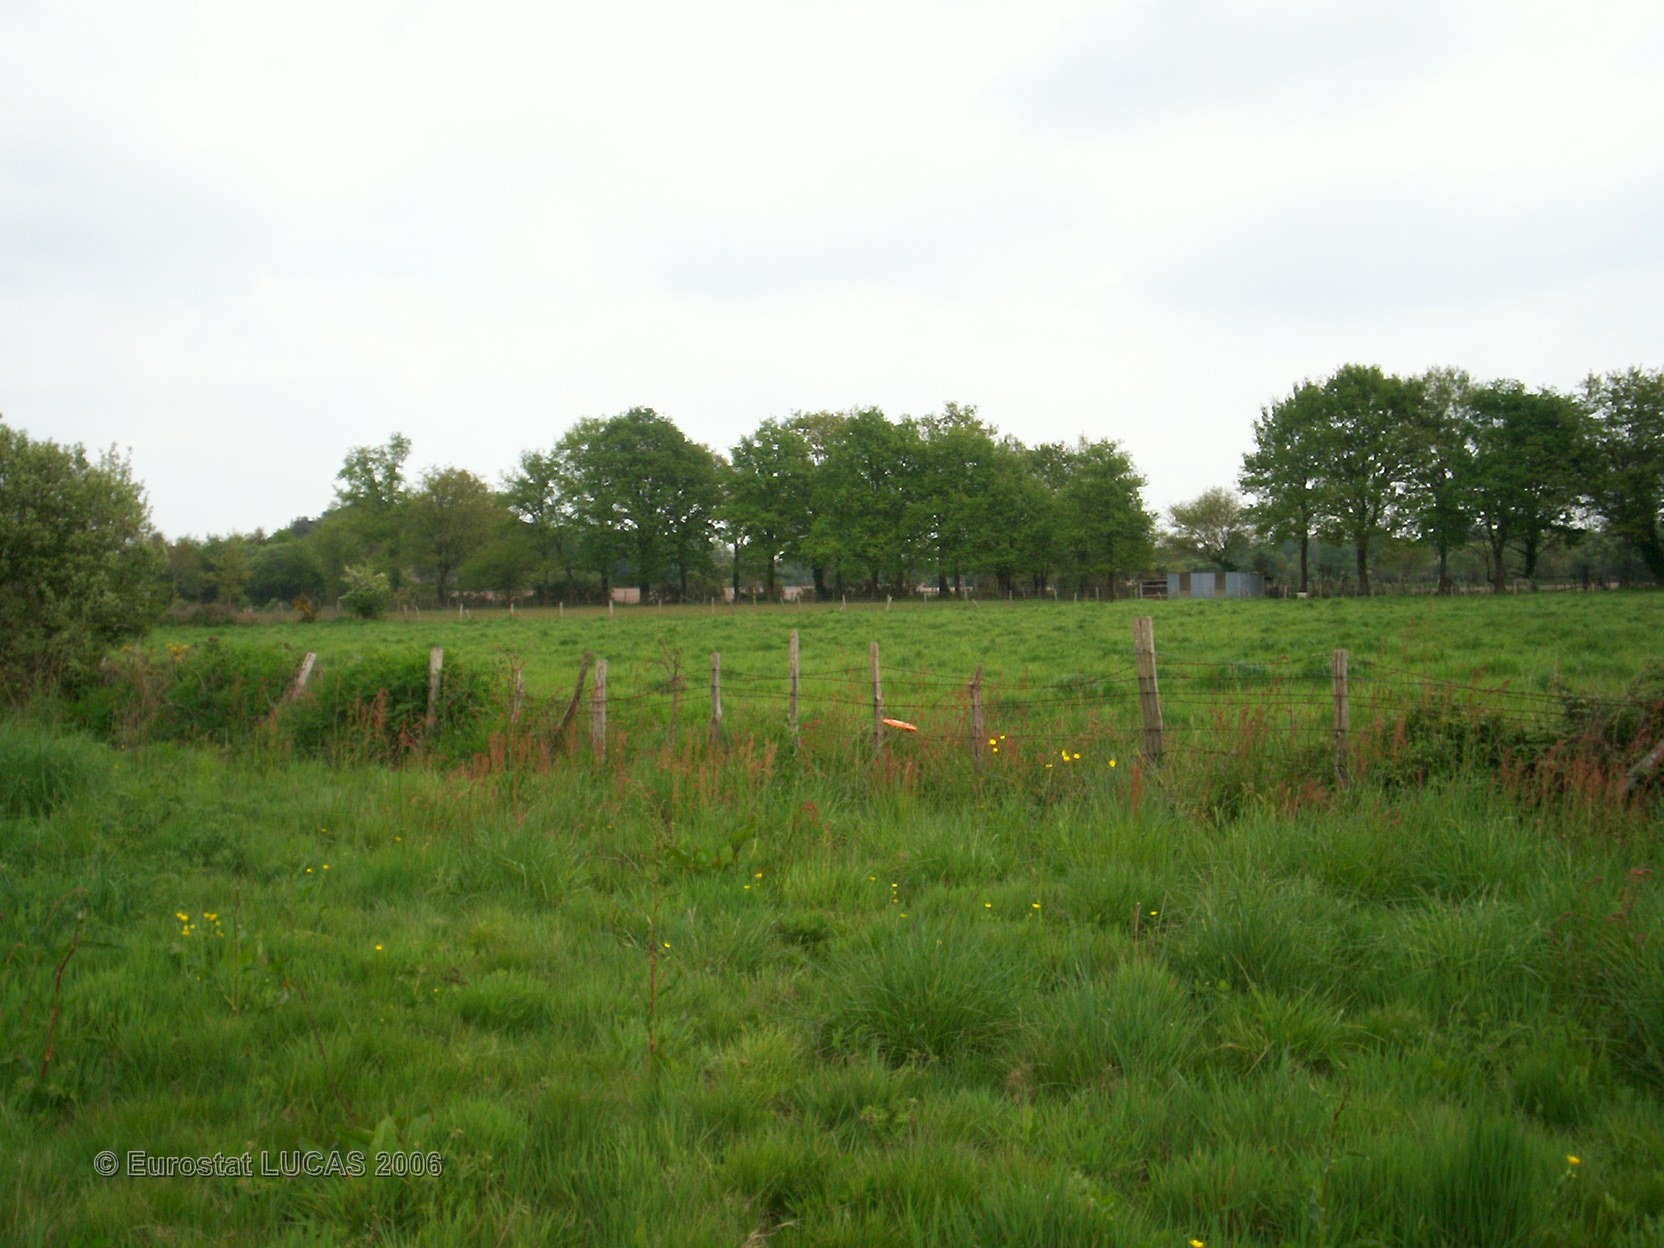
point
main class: Grassland
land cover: Grassland without tree/shrub cover
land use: Agriculture (excluding fallow land and kitchen gardens)
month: May
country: FR
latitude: 47.5213
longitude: -2.2313
